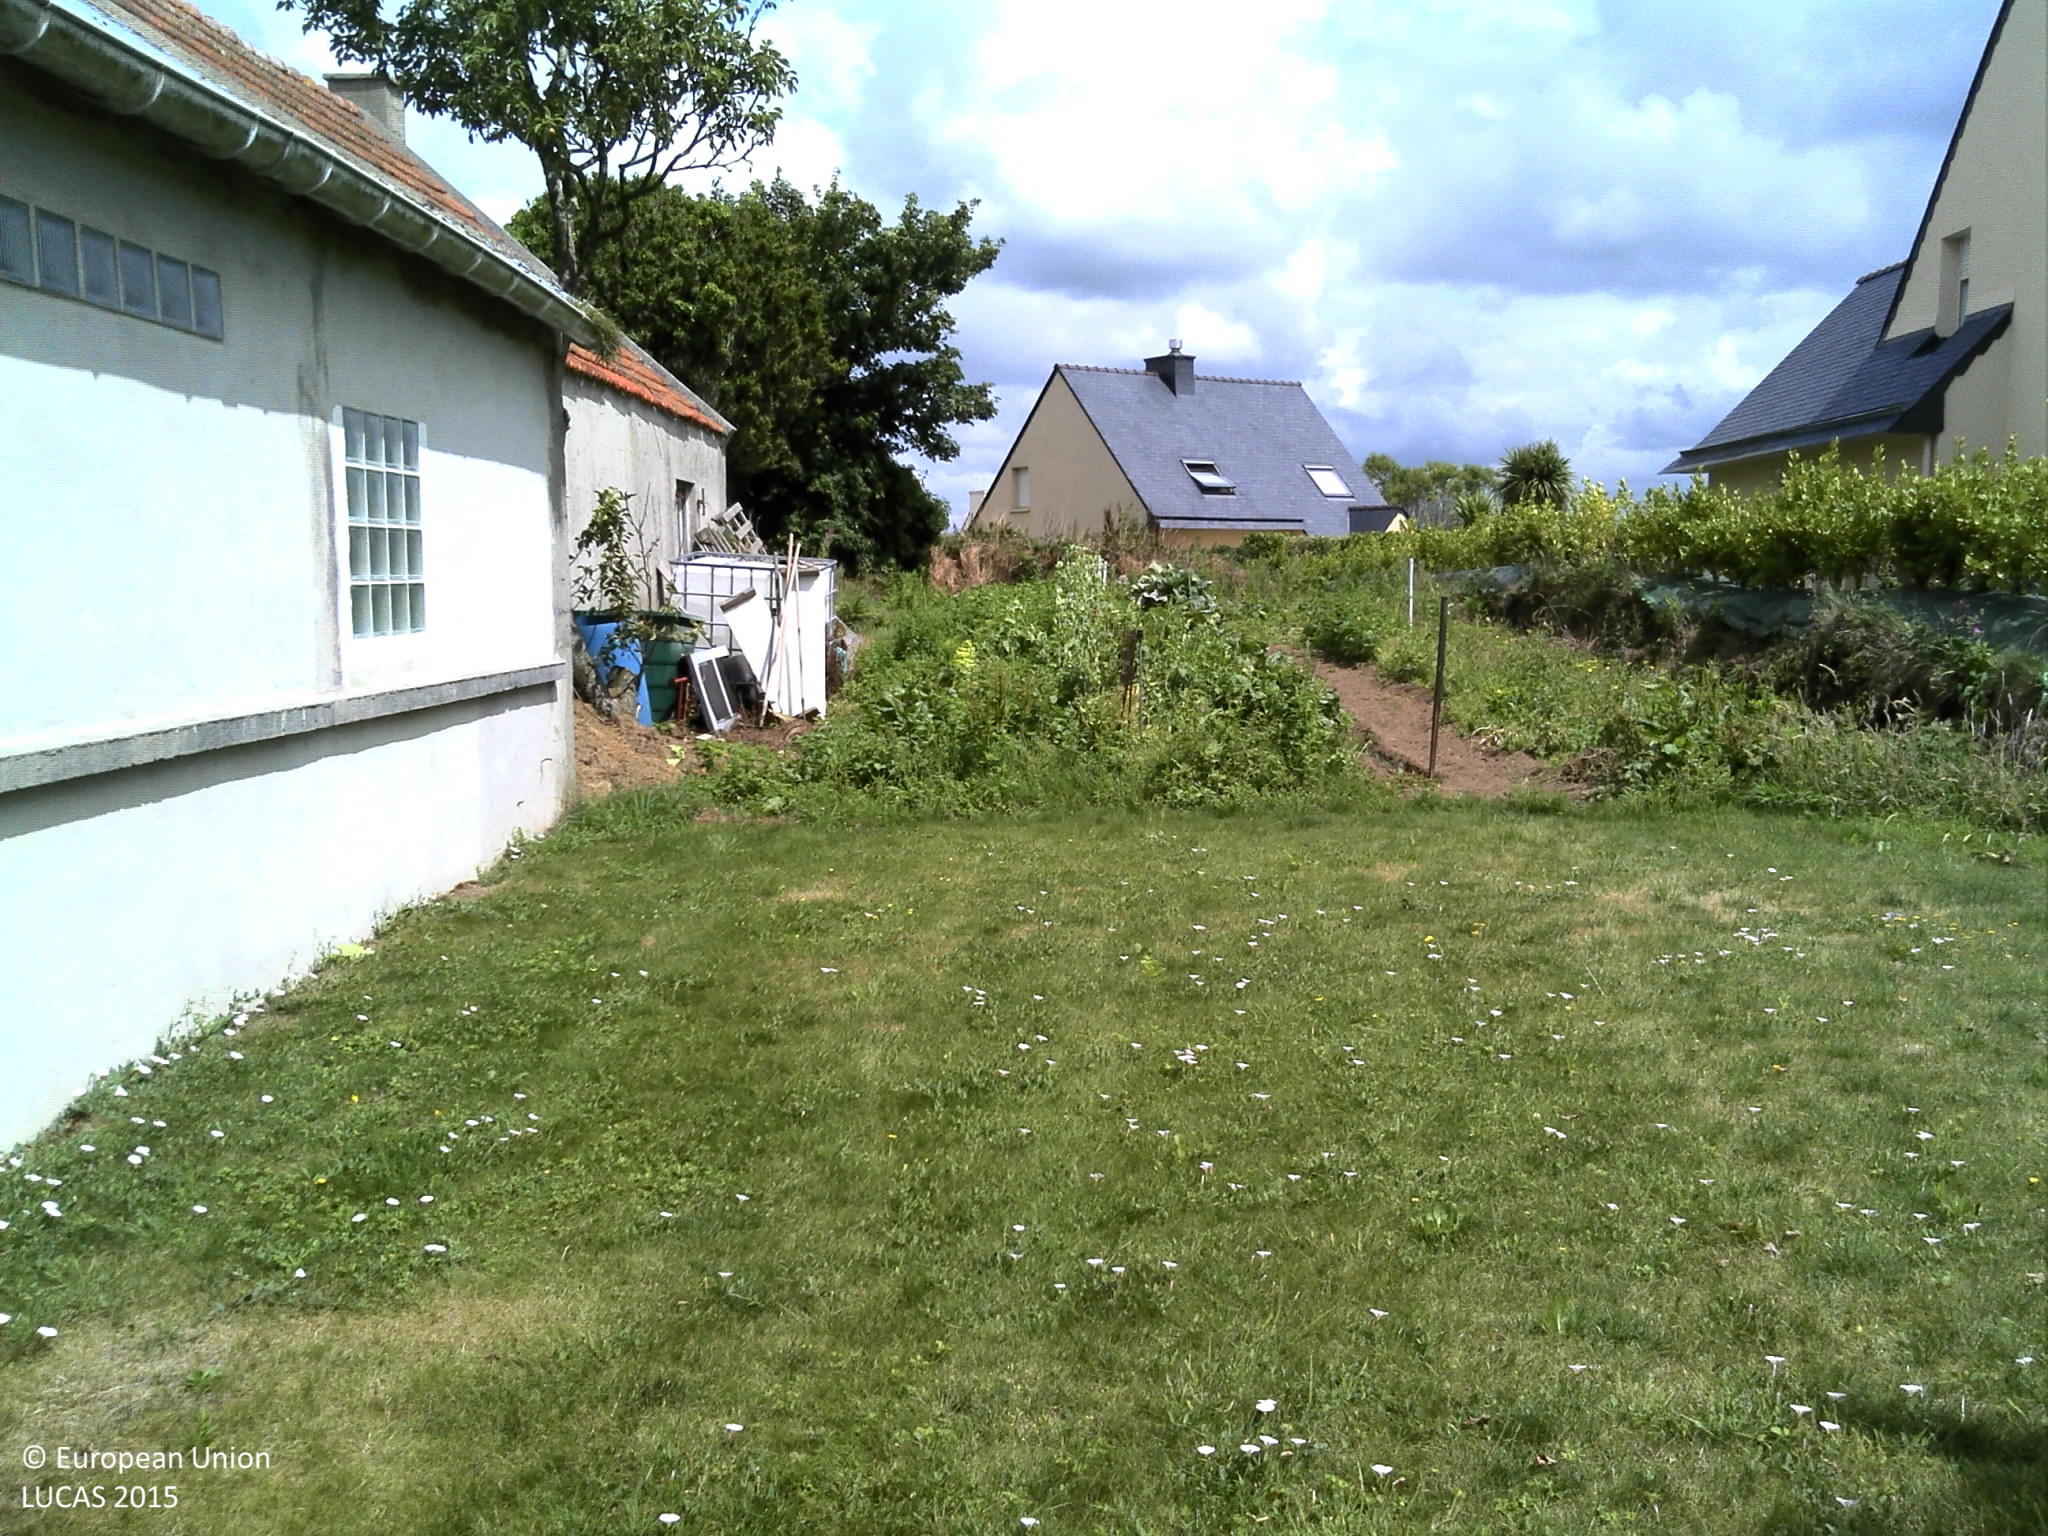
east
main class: Grassland
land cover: Grassland without tree/shrub cover
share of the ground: > 75 %
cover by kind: herbaceous plants 100 %
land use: Logistics and storage
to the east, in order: Grassland without tree/shrub cover; Artificial constructions in urban areas; Grassland without tree/shrub cover; Artificial constructions in urban areas
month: July
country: FR
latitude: 48.5243
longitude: -4.6030
